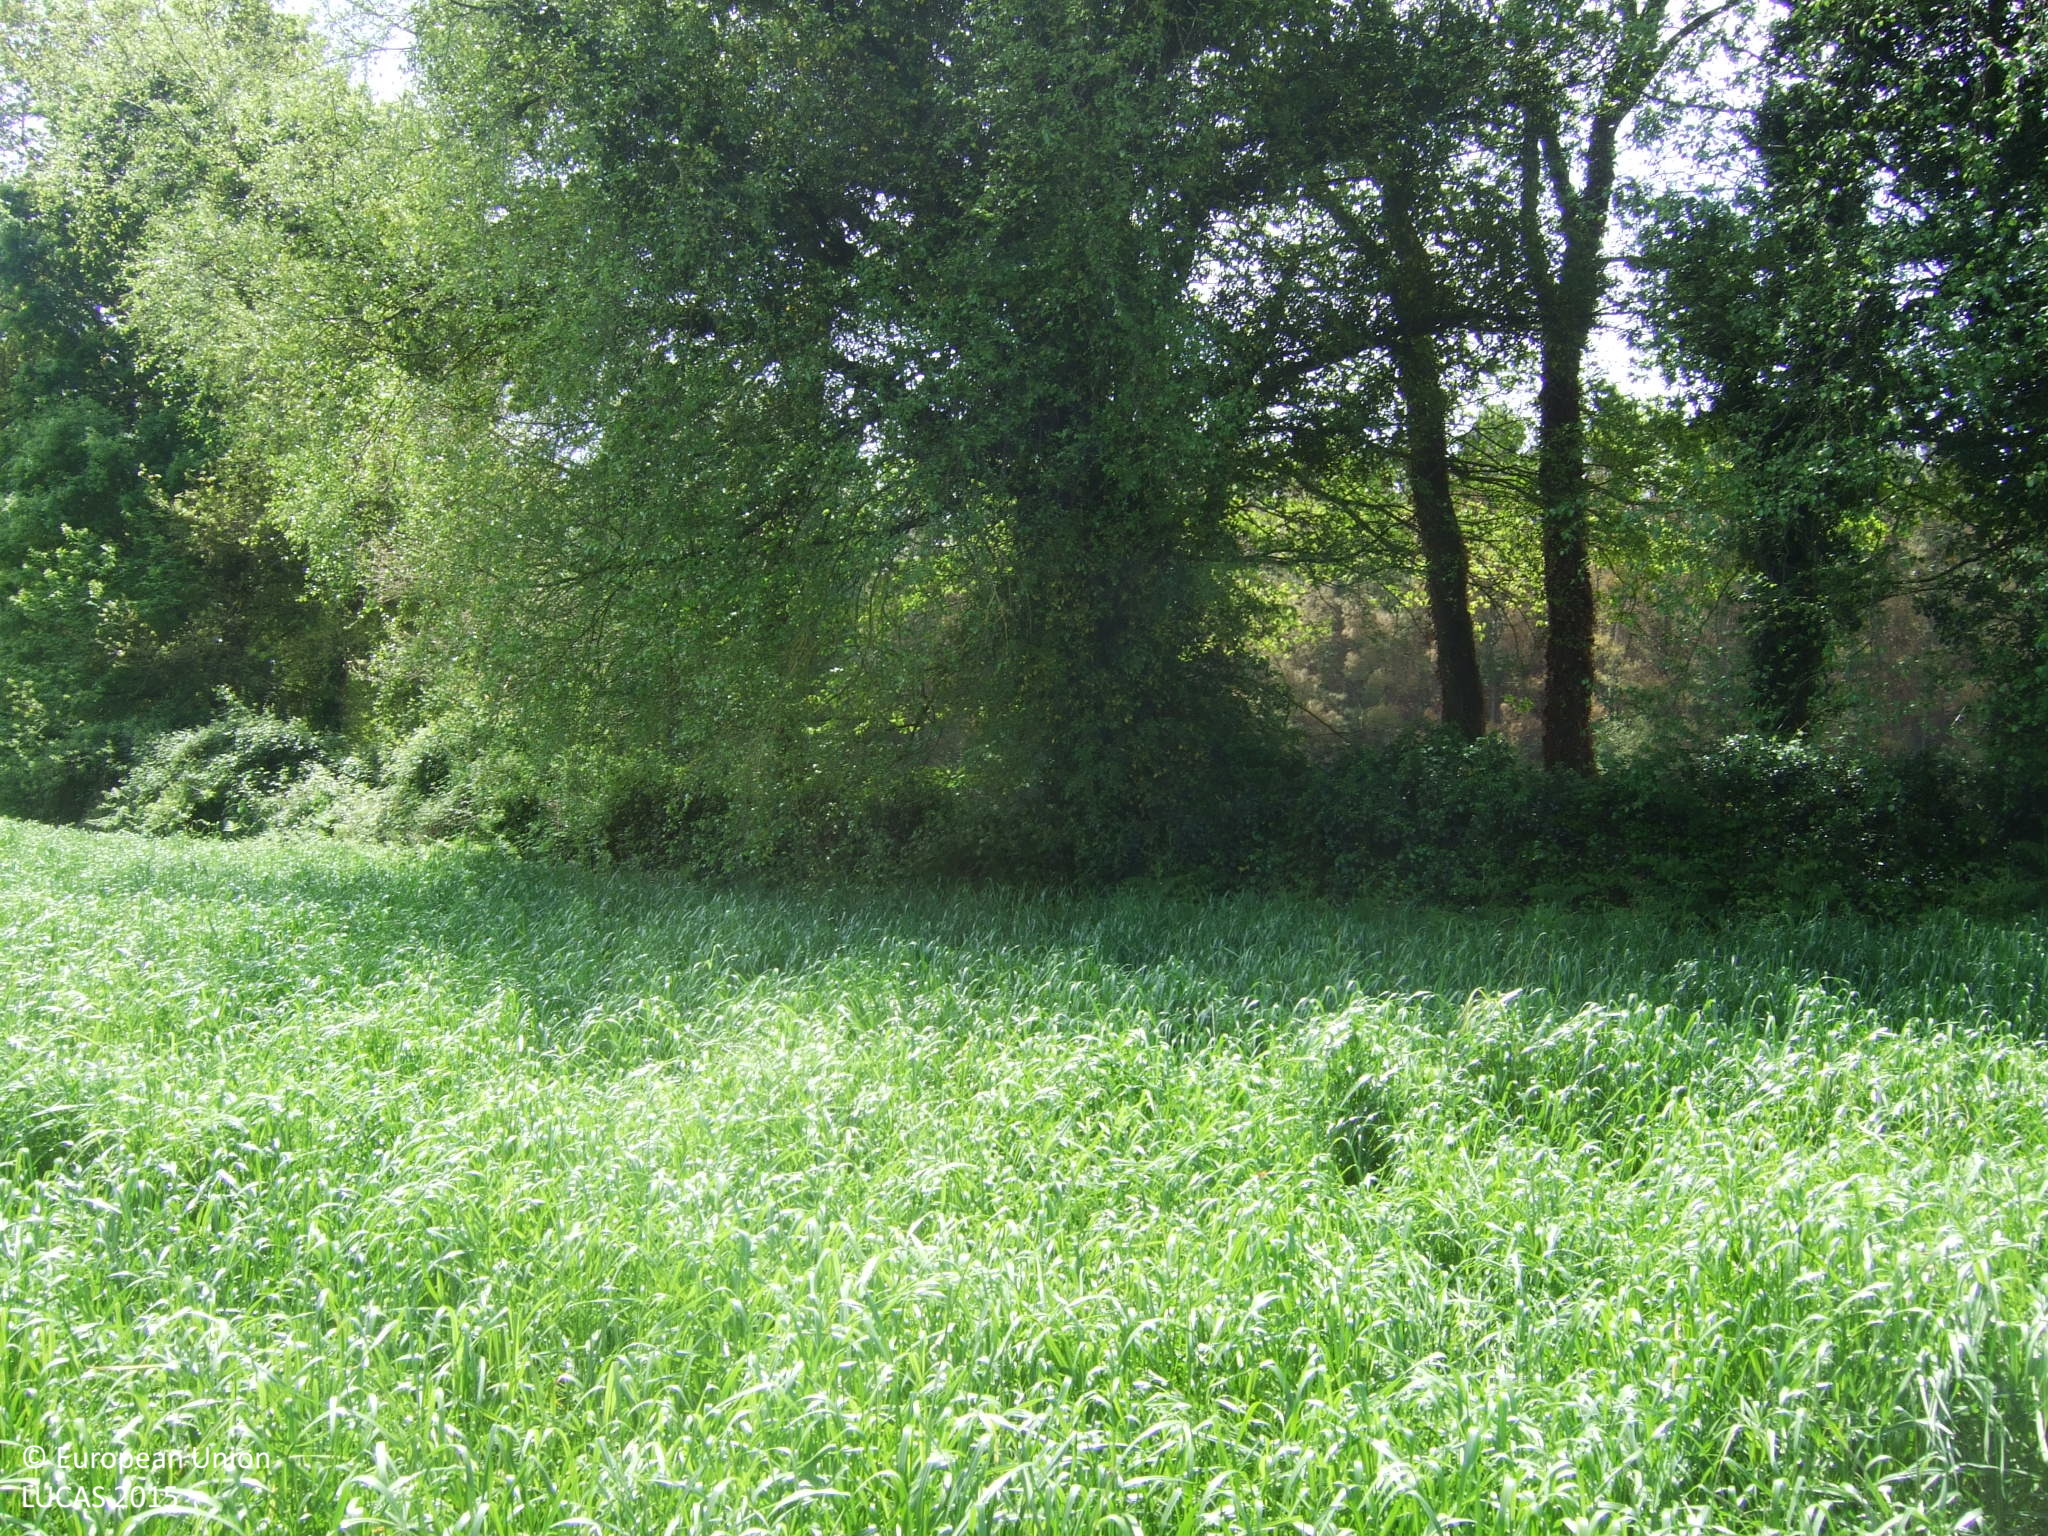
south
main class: Cropland
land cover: Temporary grasslands
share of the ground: > 75 %
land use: Agriculture (excluding fallow land and kitchen gardens)
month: May
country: ES
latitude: 43.0165
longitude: -7.3856
